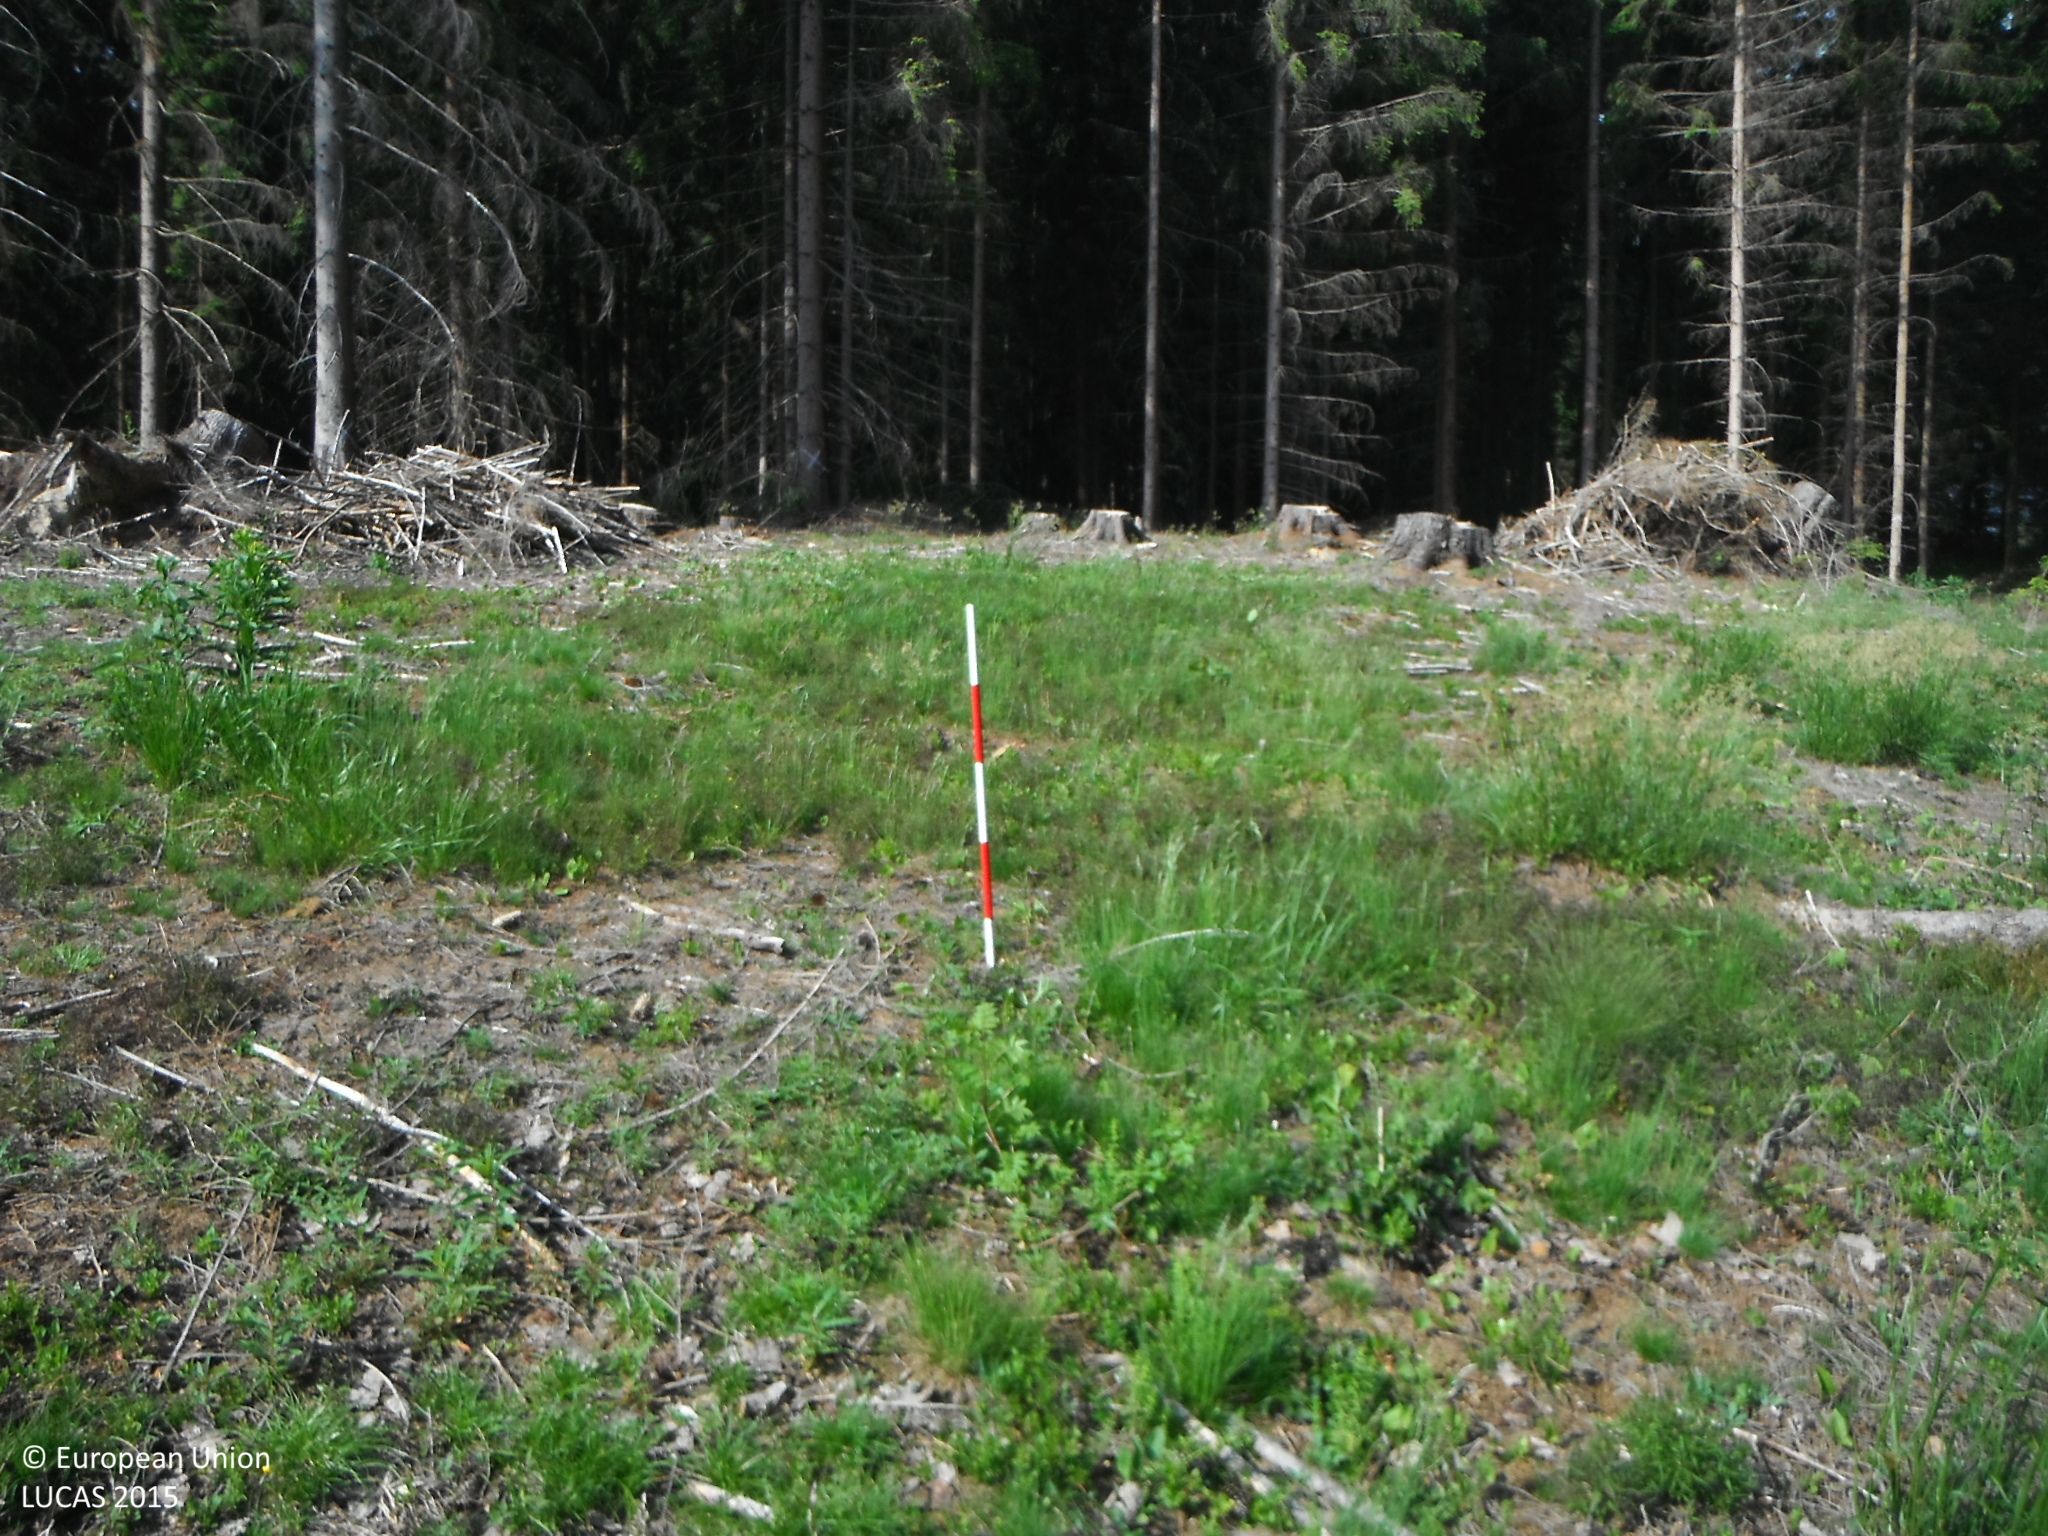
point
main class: Grassland
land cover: Spontaneously vegetated surfaces
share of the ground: > 75 %
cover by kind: herbaceous plants 75 %, unconsolidated bare surface 25 %
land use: Forestry
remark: Clear cut
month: June
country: SK
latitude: 49.0712
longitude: 19.8162
